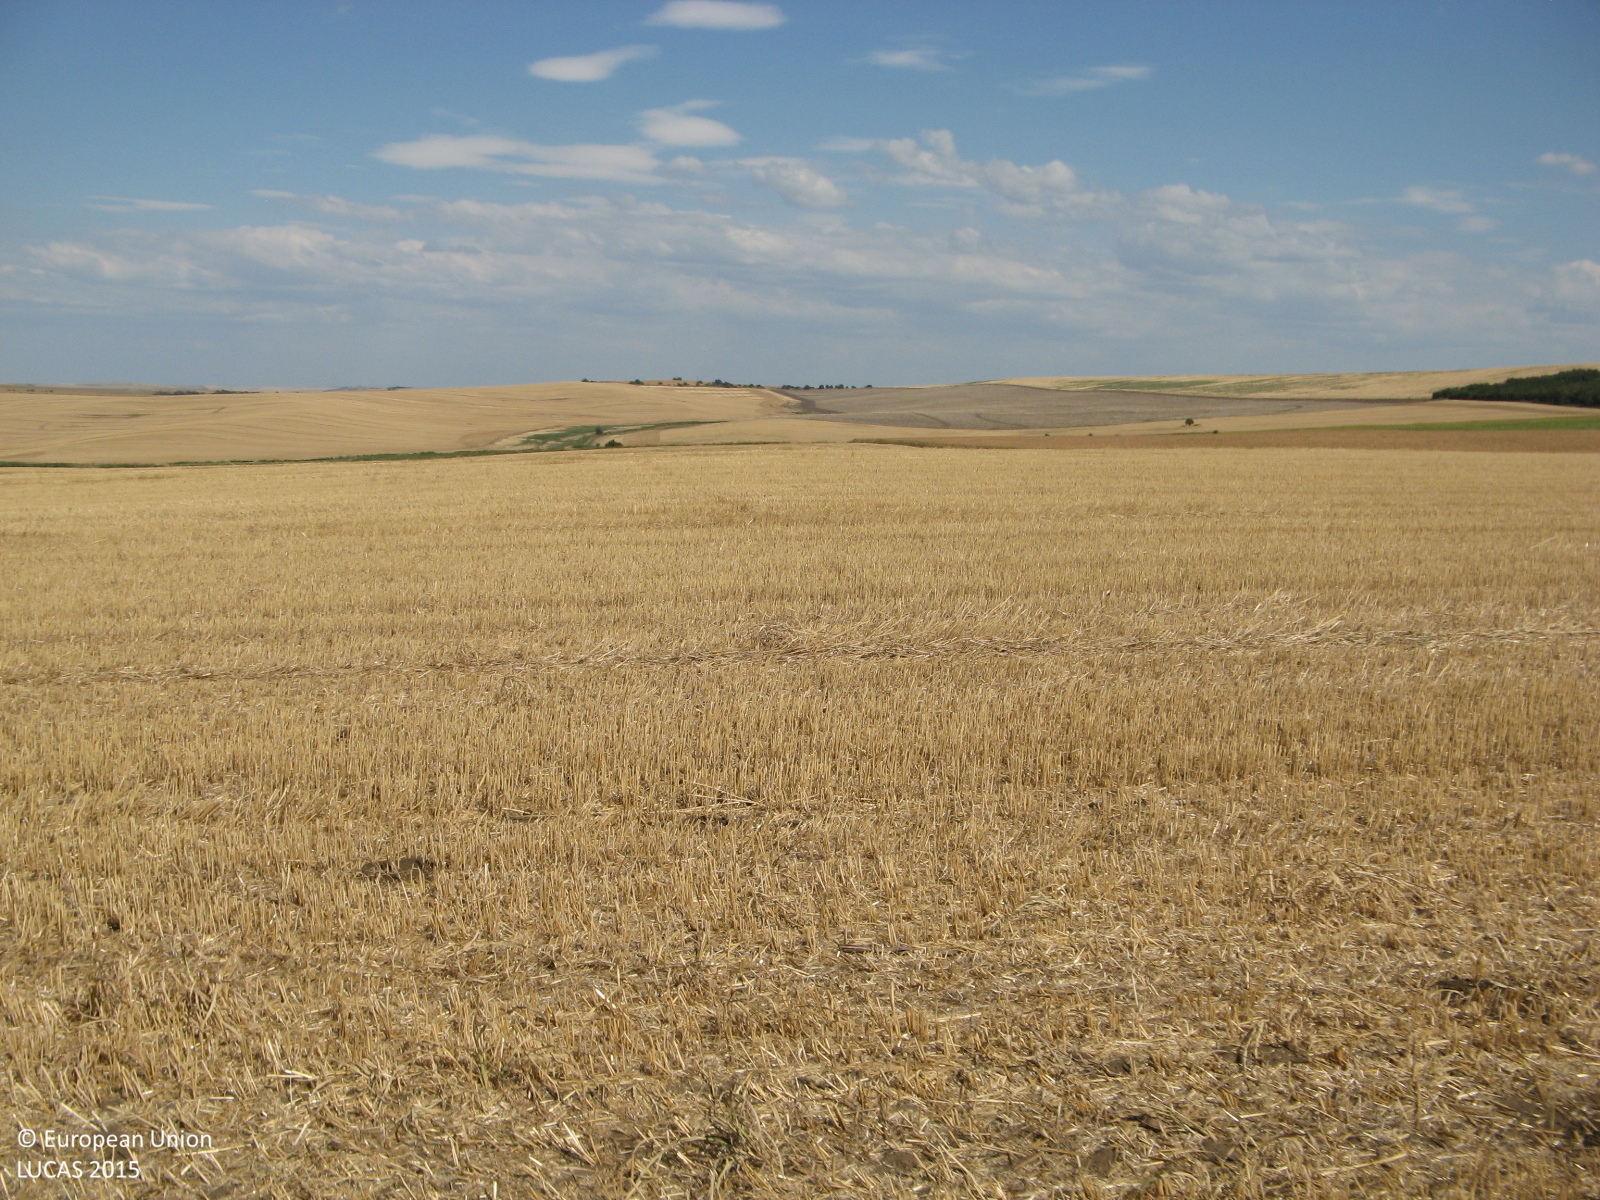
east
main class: Cropland
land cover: Common wheat
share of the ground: 50 - 75 %
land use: Agriculture (excluding fallow land and kitchen gardens)
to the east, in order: Common wheat
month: August
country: BG
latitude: 43.4297
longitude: 25.4091
